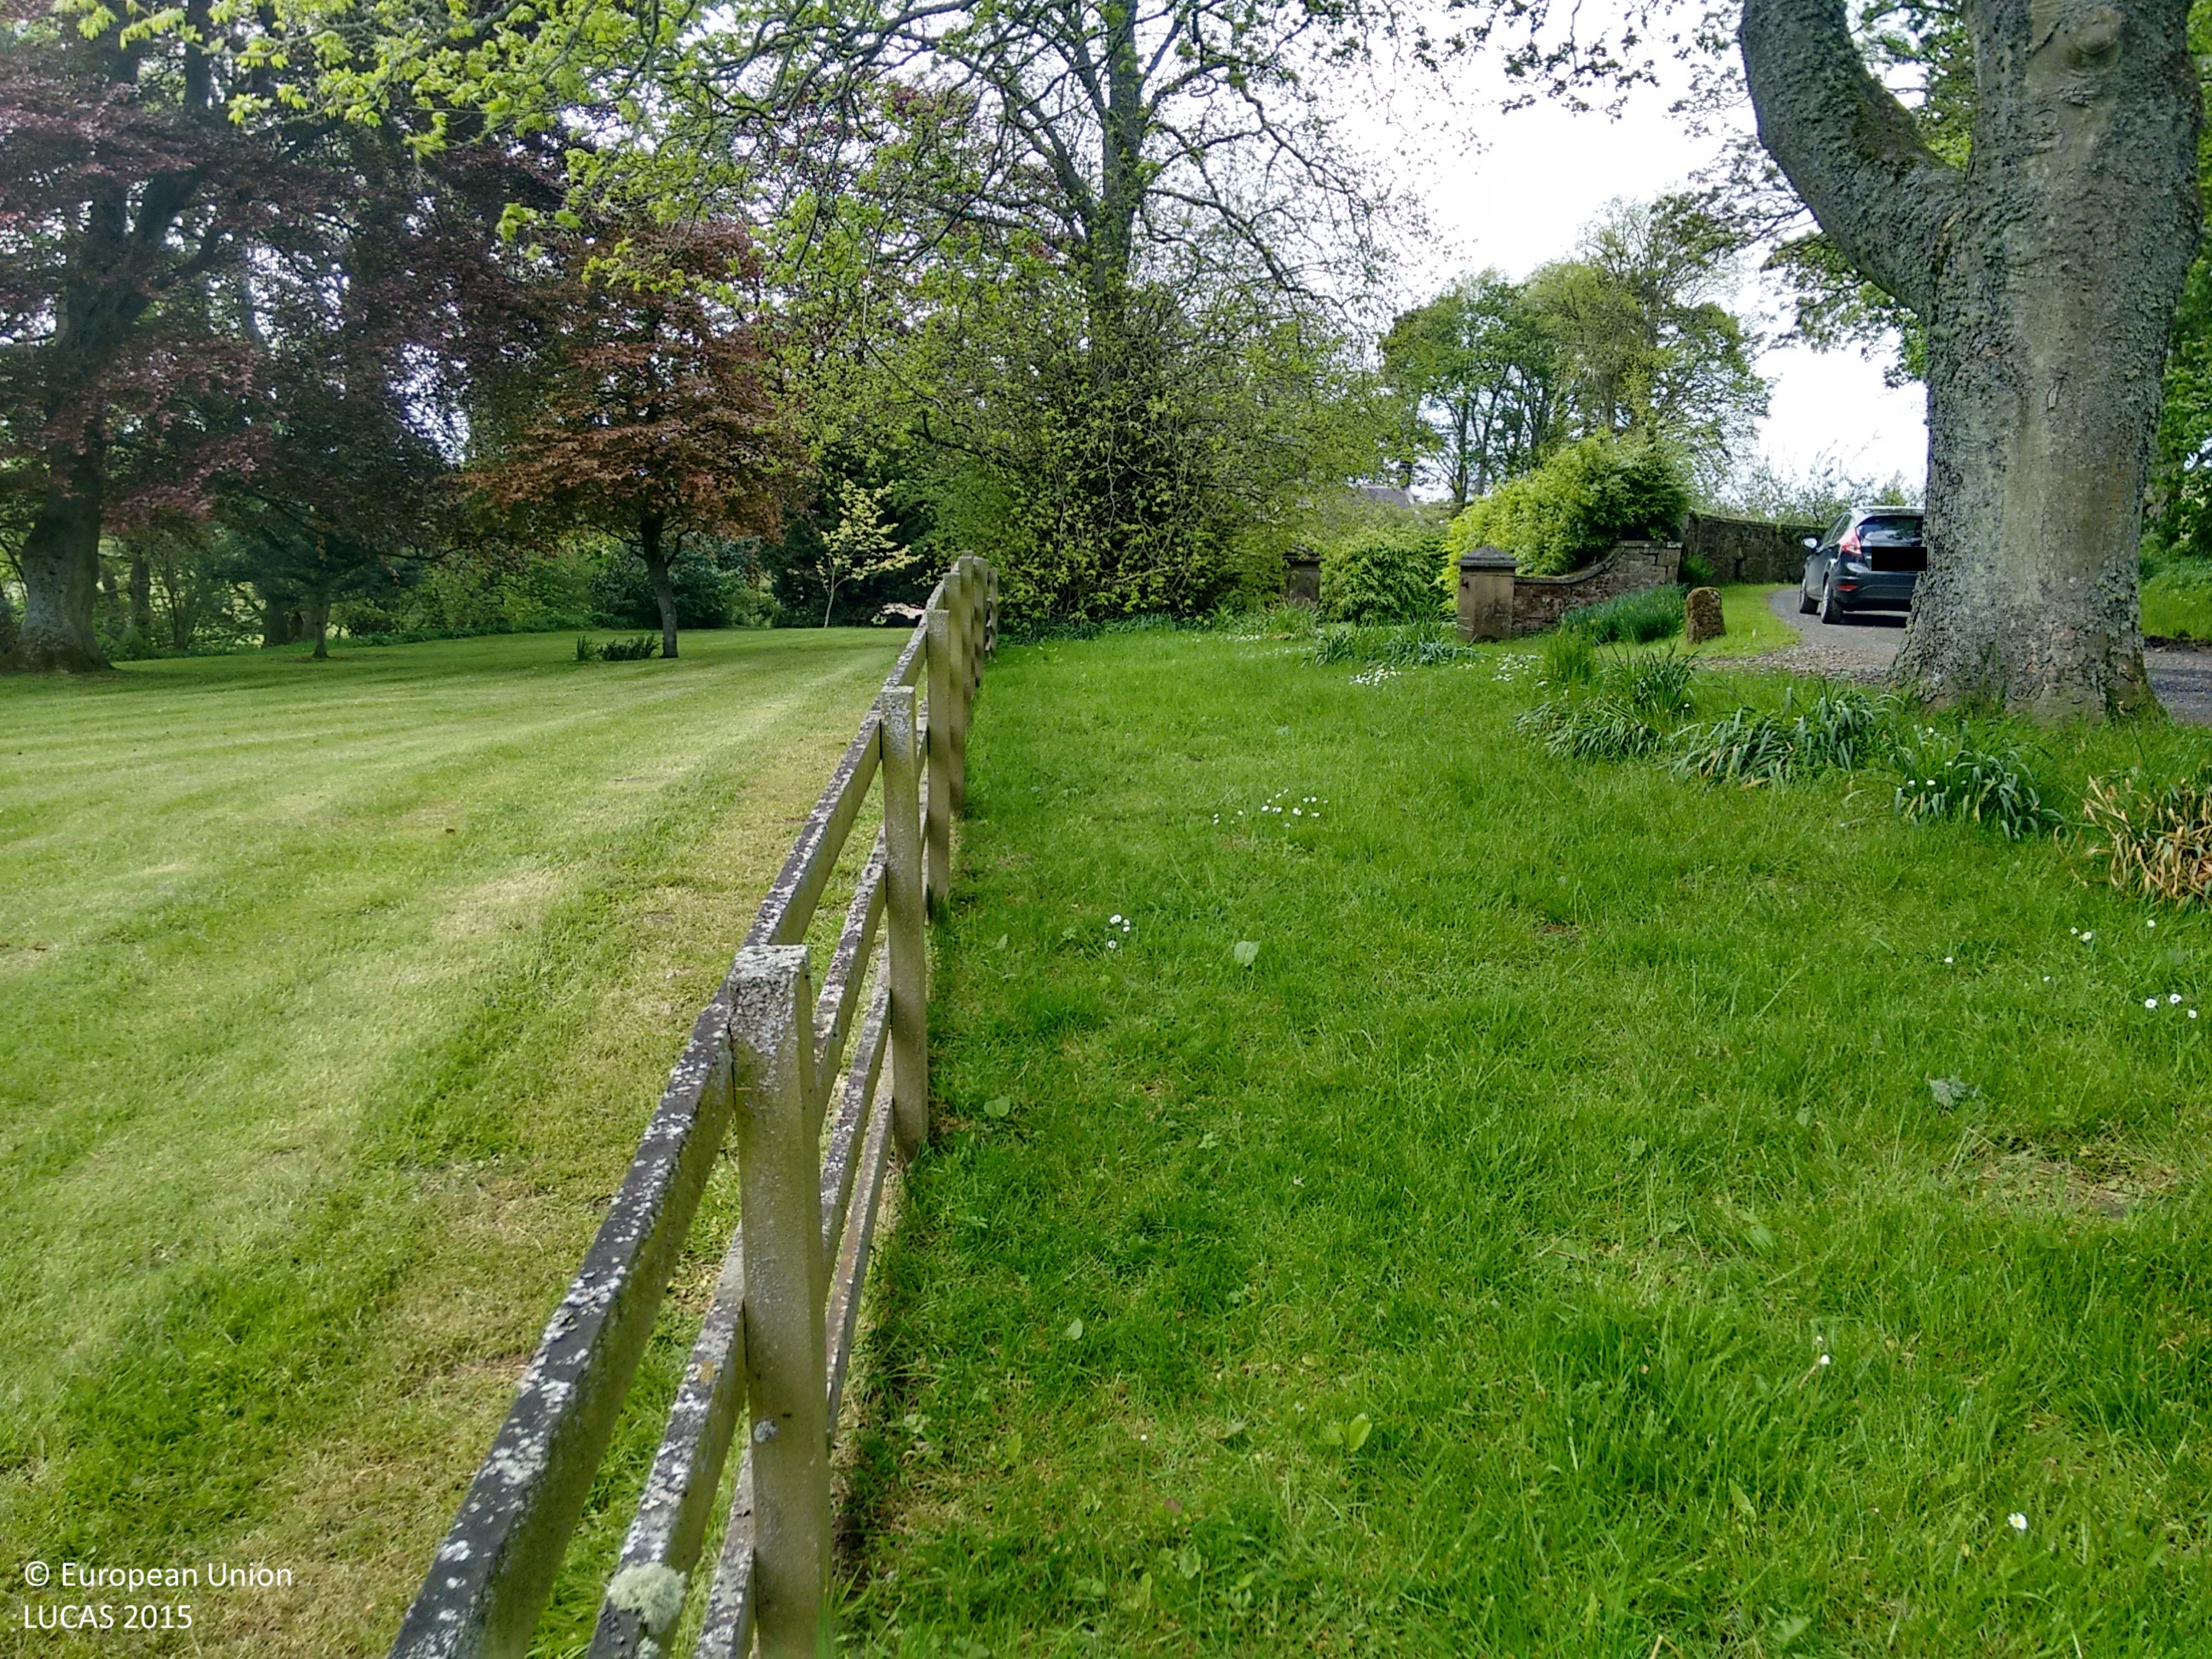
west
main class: Grassland
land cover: Grassland with sparse tree/shrub cover
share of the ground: > 75 %
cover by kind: herbaceous plants 95 %, broadleaved forest trees 5 %
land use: Residential
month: May
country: GB
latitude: 55.1547
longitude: -2.3157
